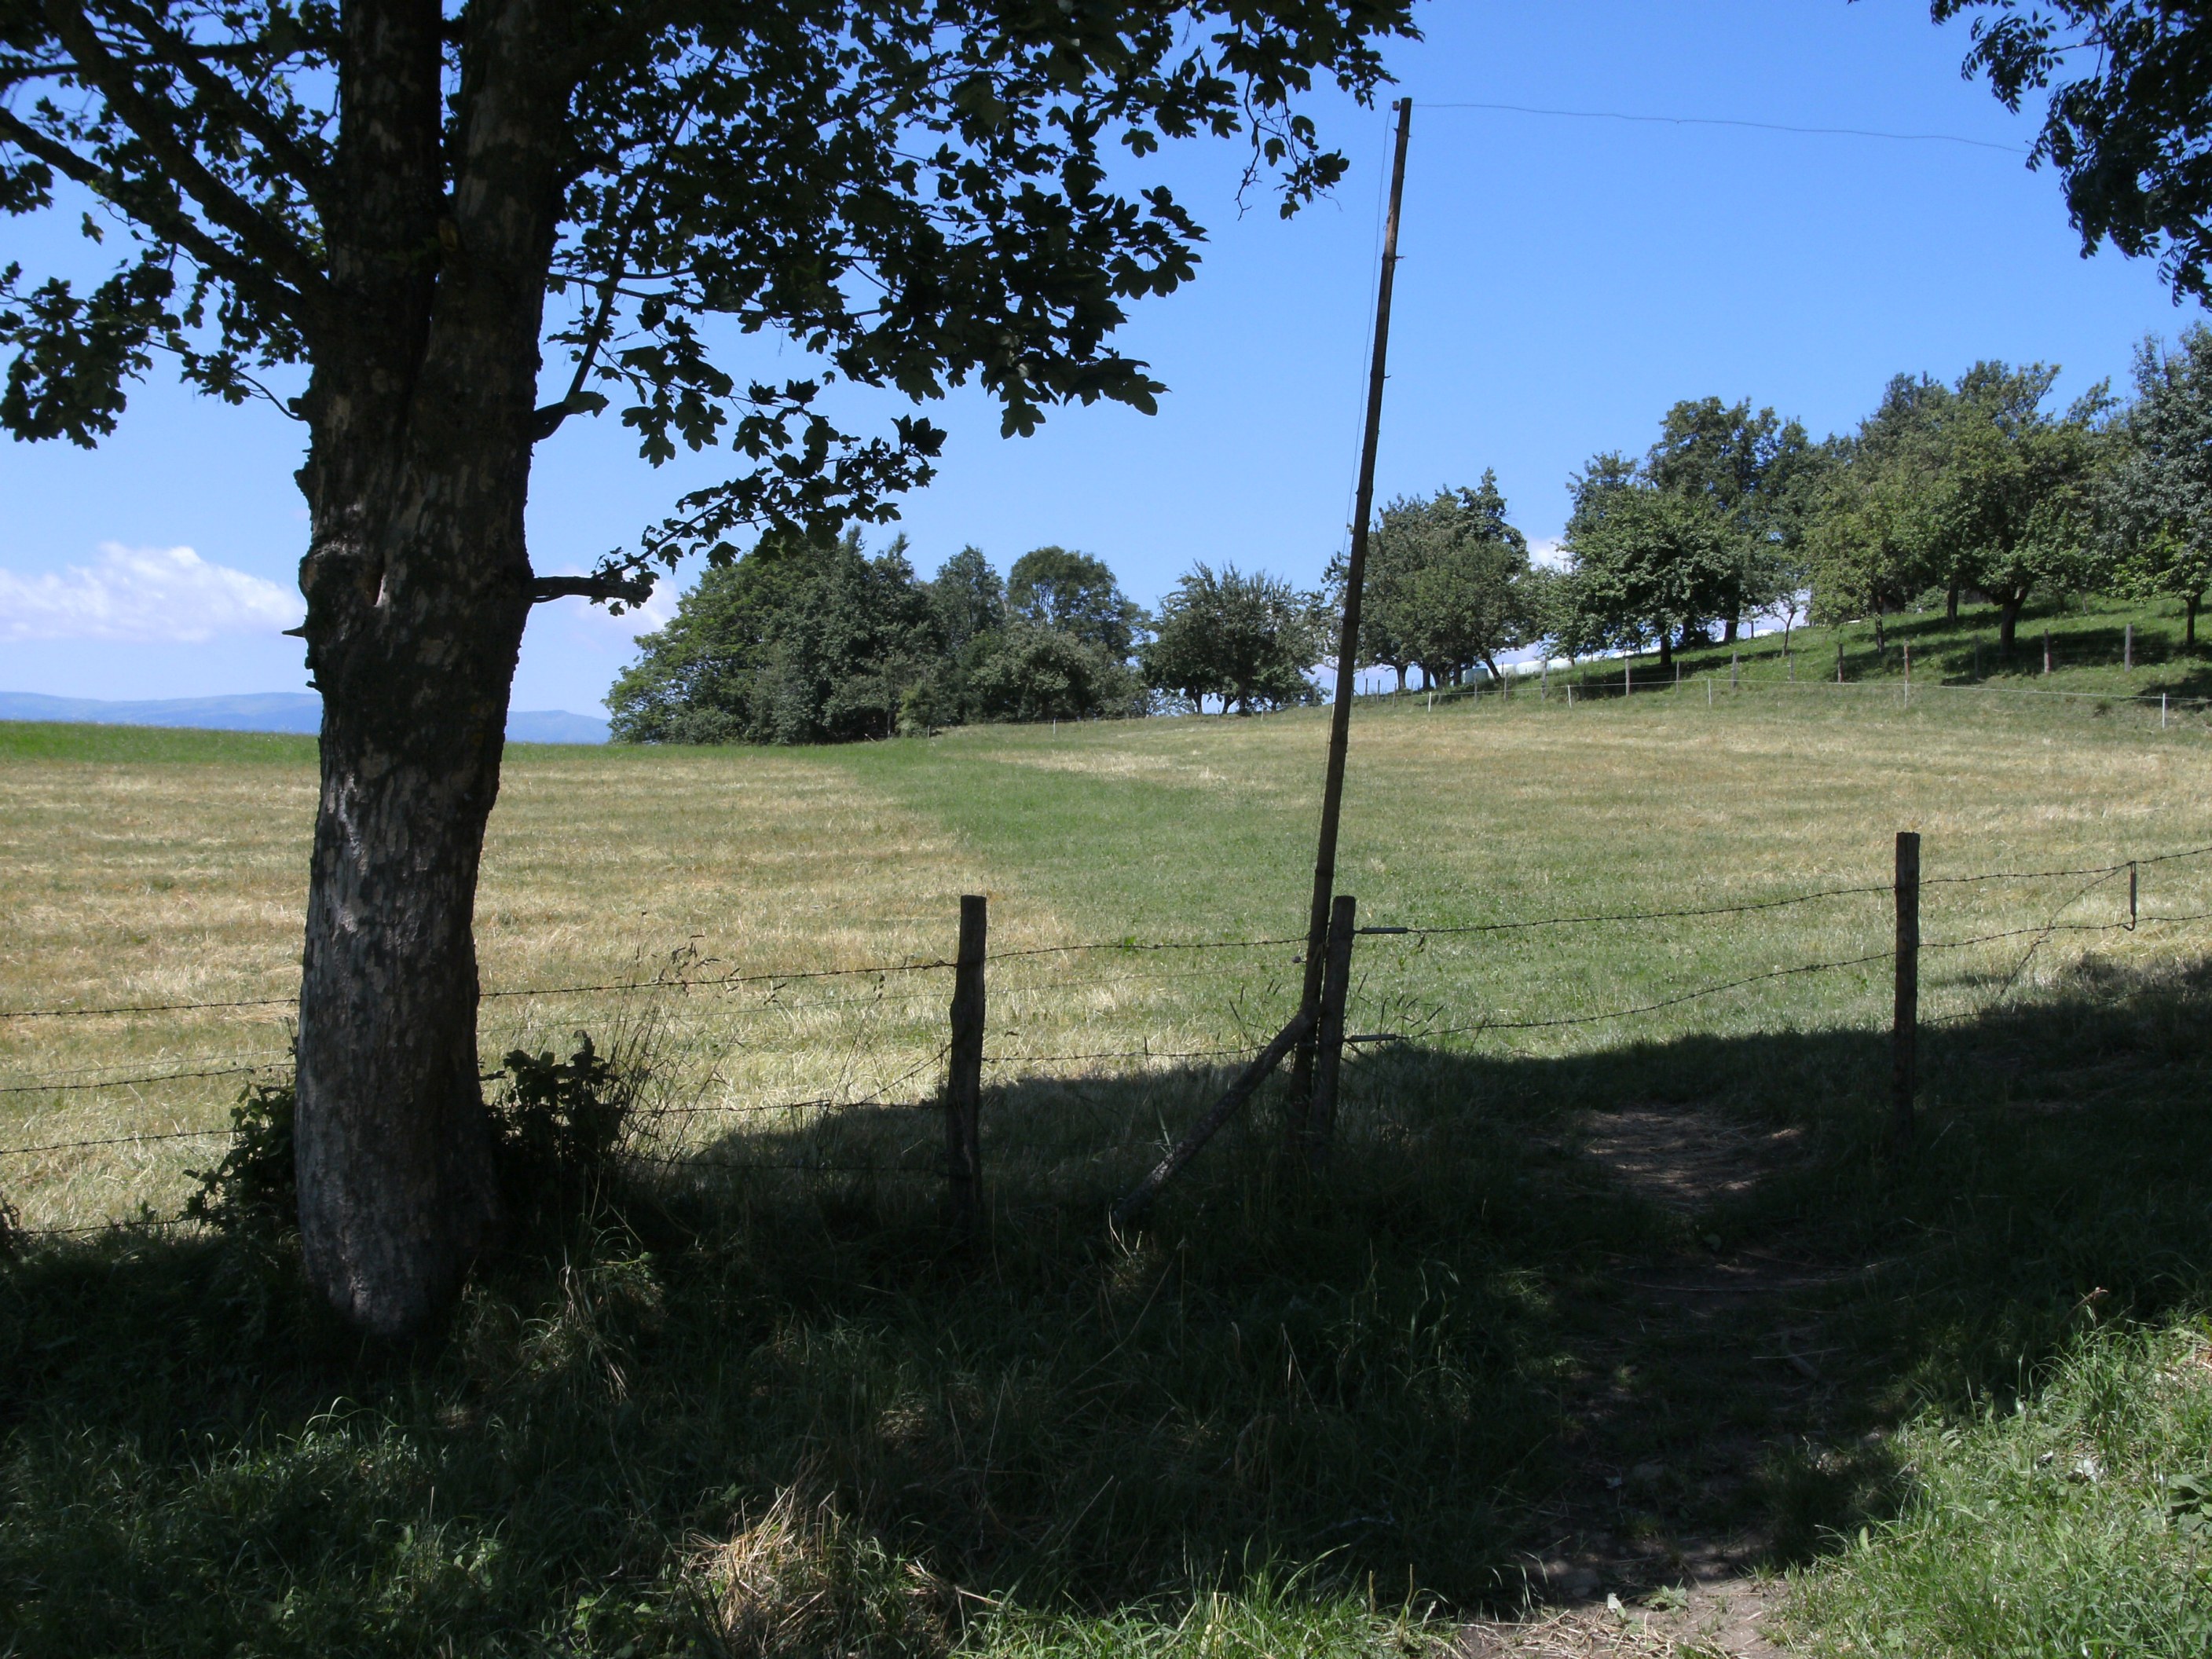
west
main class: Grassland
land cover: Grassland without tree/shrub cover
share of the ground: > 75 %
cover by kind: herbaceous plants 100 %
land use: Agriculture (excluding fallow land and kitchen gardens)
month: July
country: AT
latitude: 46.9067
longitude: 14.8955
